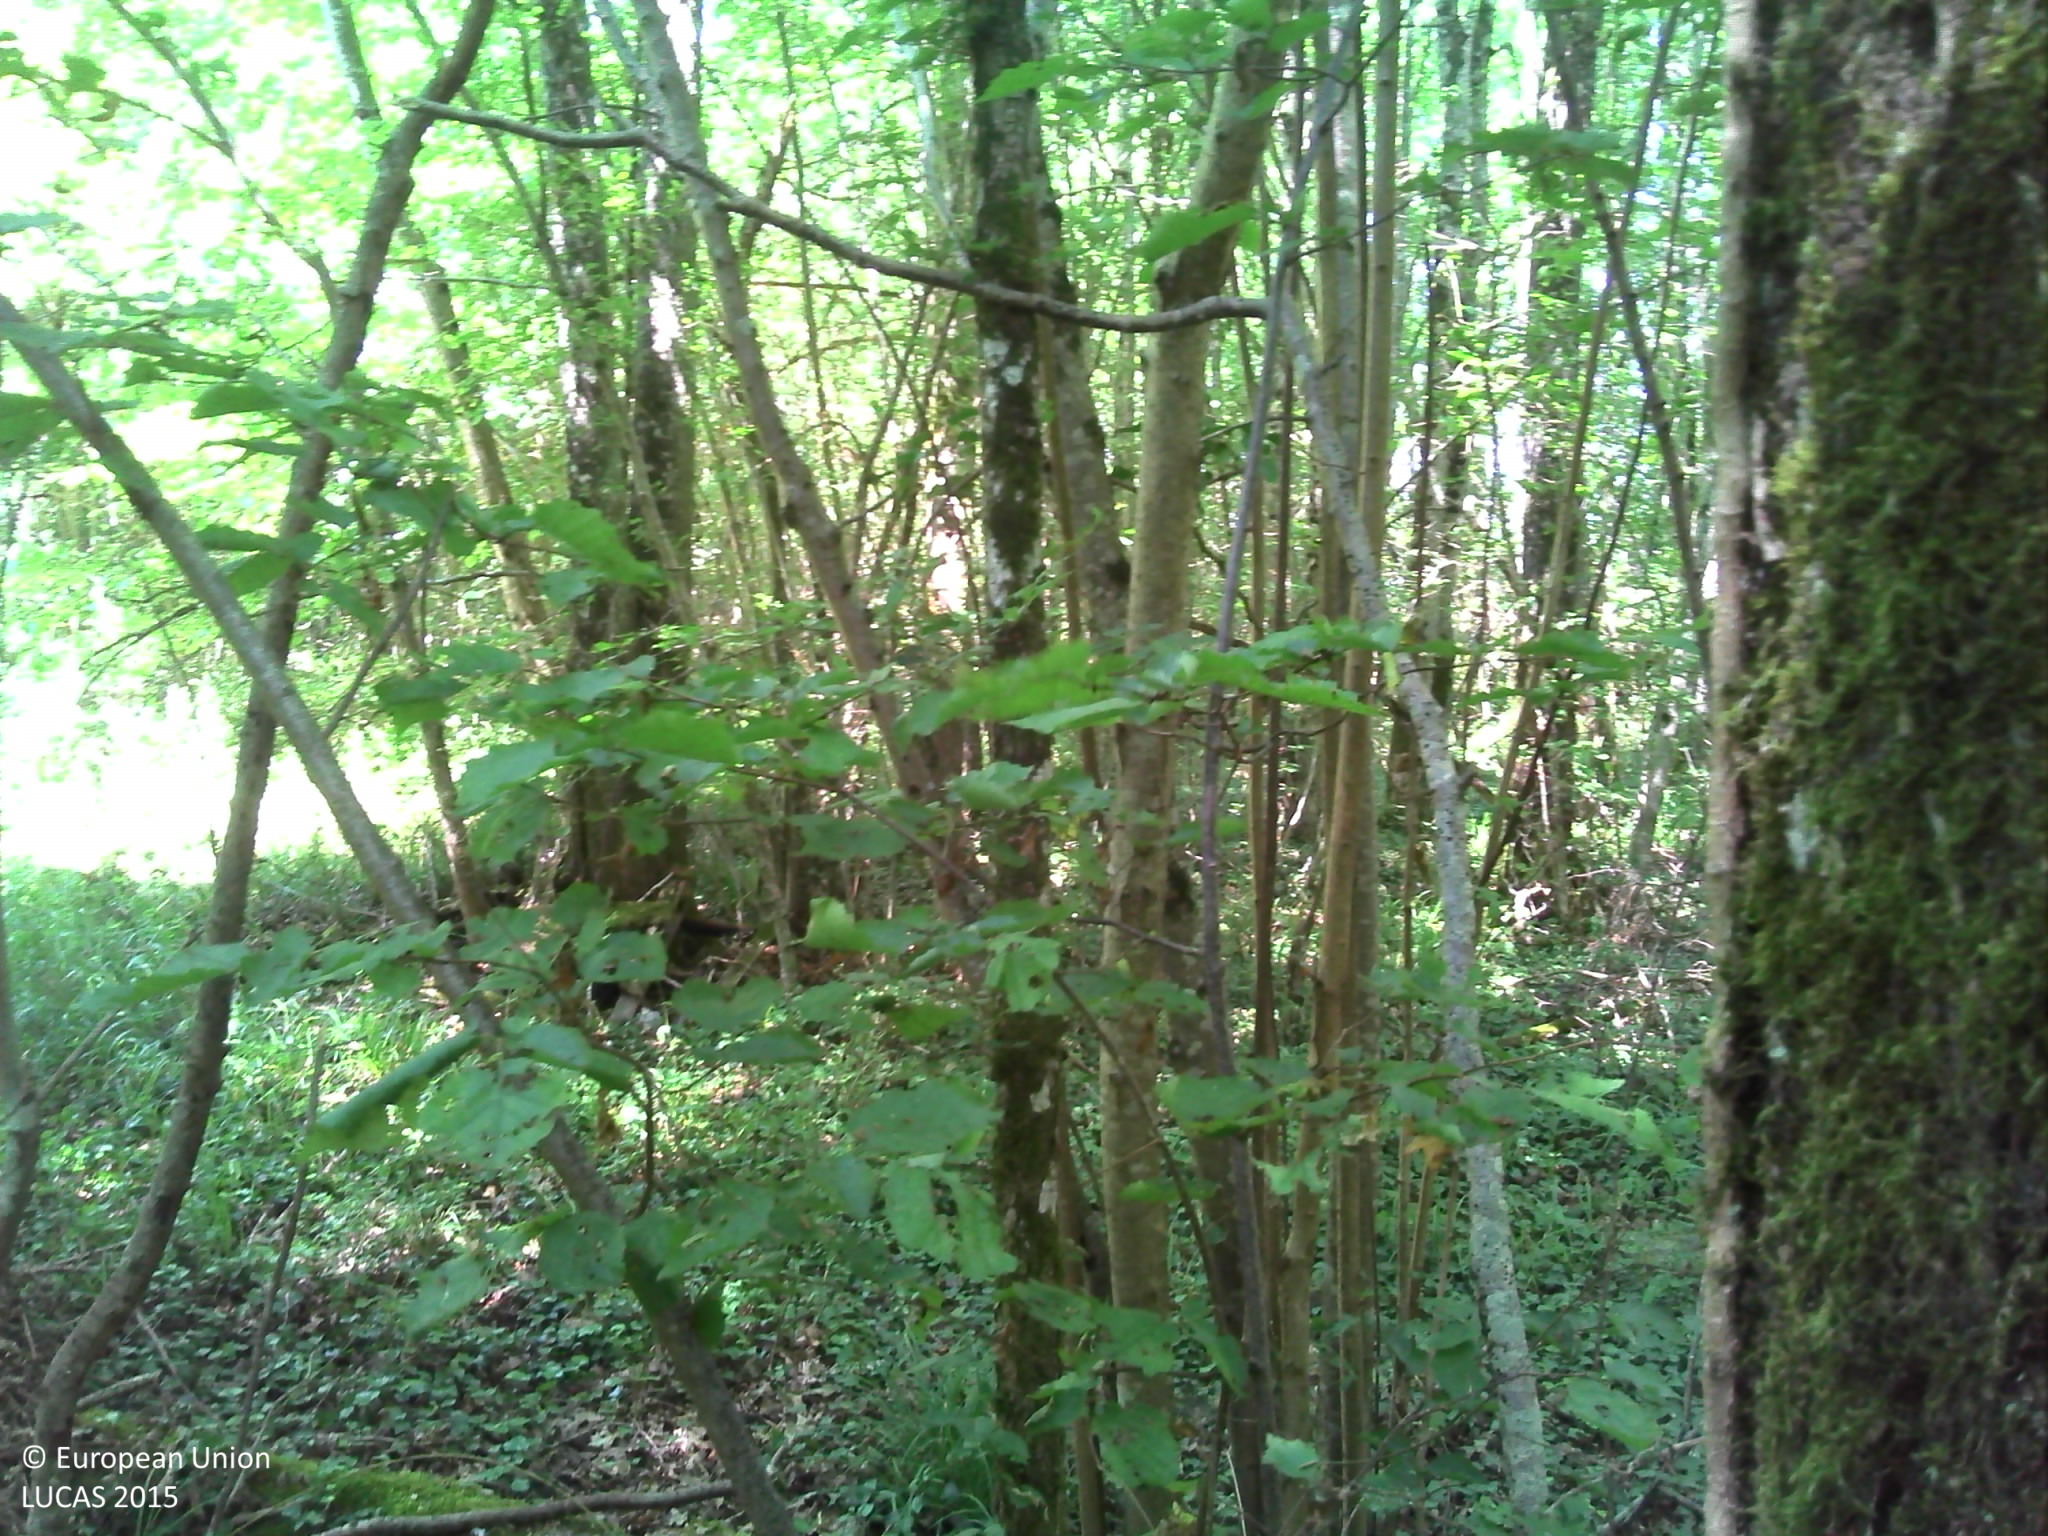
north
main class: Woodland
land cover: Broadleaved woodland
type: mesophytic deciduous forest
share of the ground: > 75 %
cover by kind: broadleaved forest trees 100 %
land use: Forestry
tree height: > 5 m
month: July
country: FR
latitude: 48.0039
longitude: 2.4979
